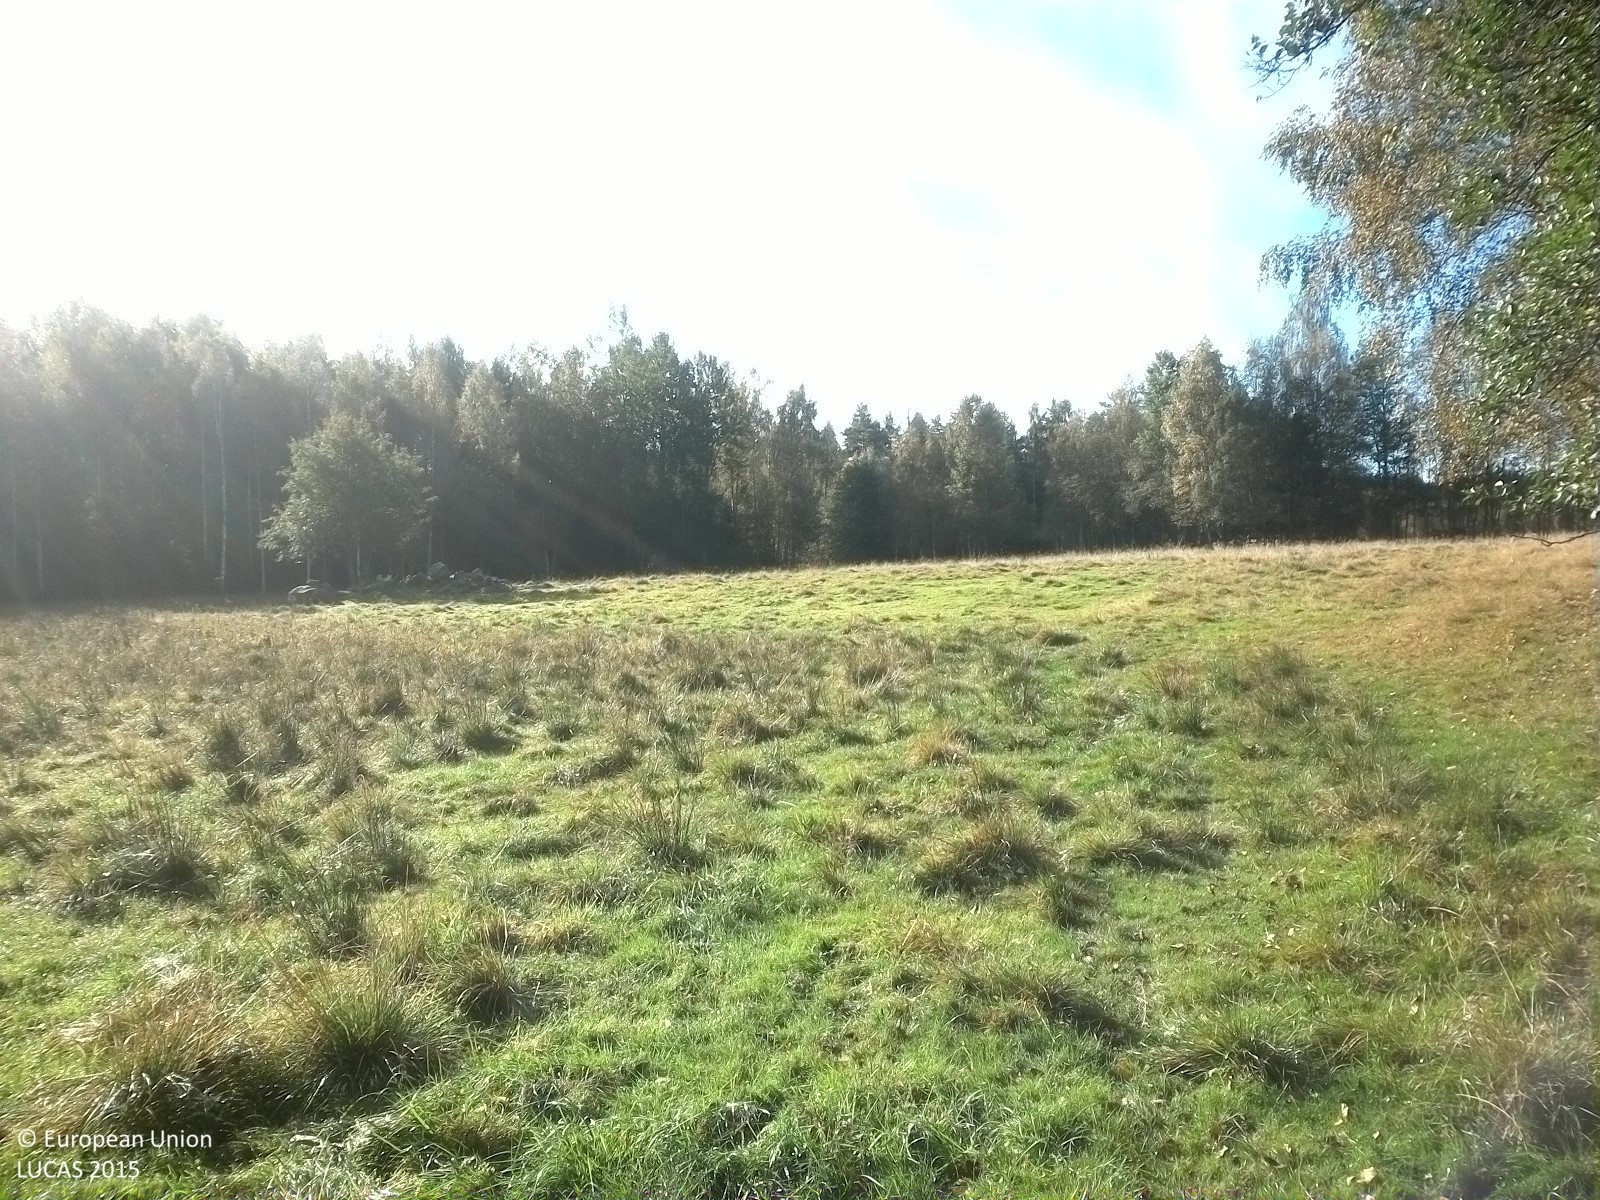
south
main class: Grassland
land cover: Grassland without tree/shrub cover
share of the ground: > 75 %
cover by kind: herbaceous plants 100 %
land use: Agriculture (excluding fallow land and kitchen gardens)
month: September
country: SE
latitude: 58.9582
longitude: 15.8524
